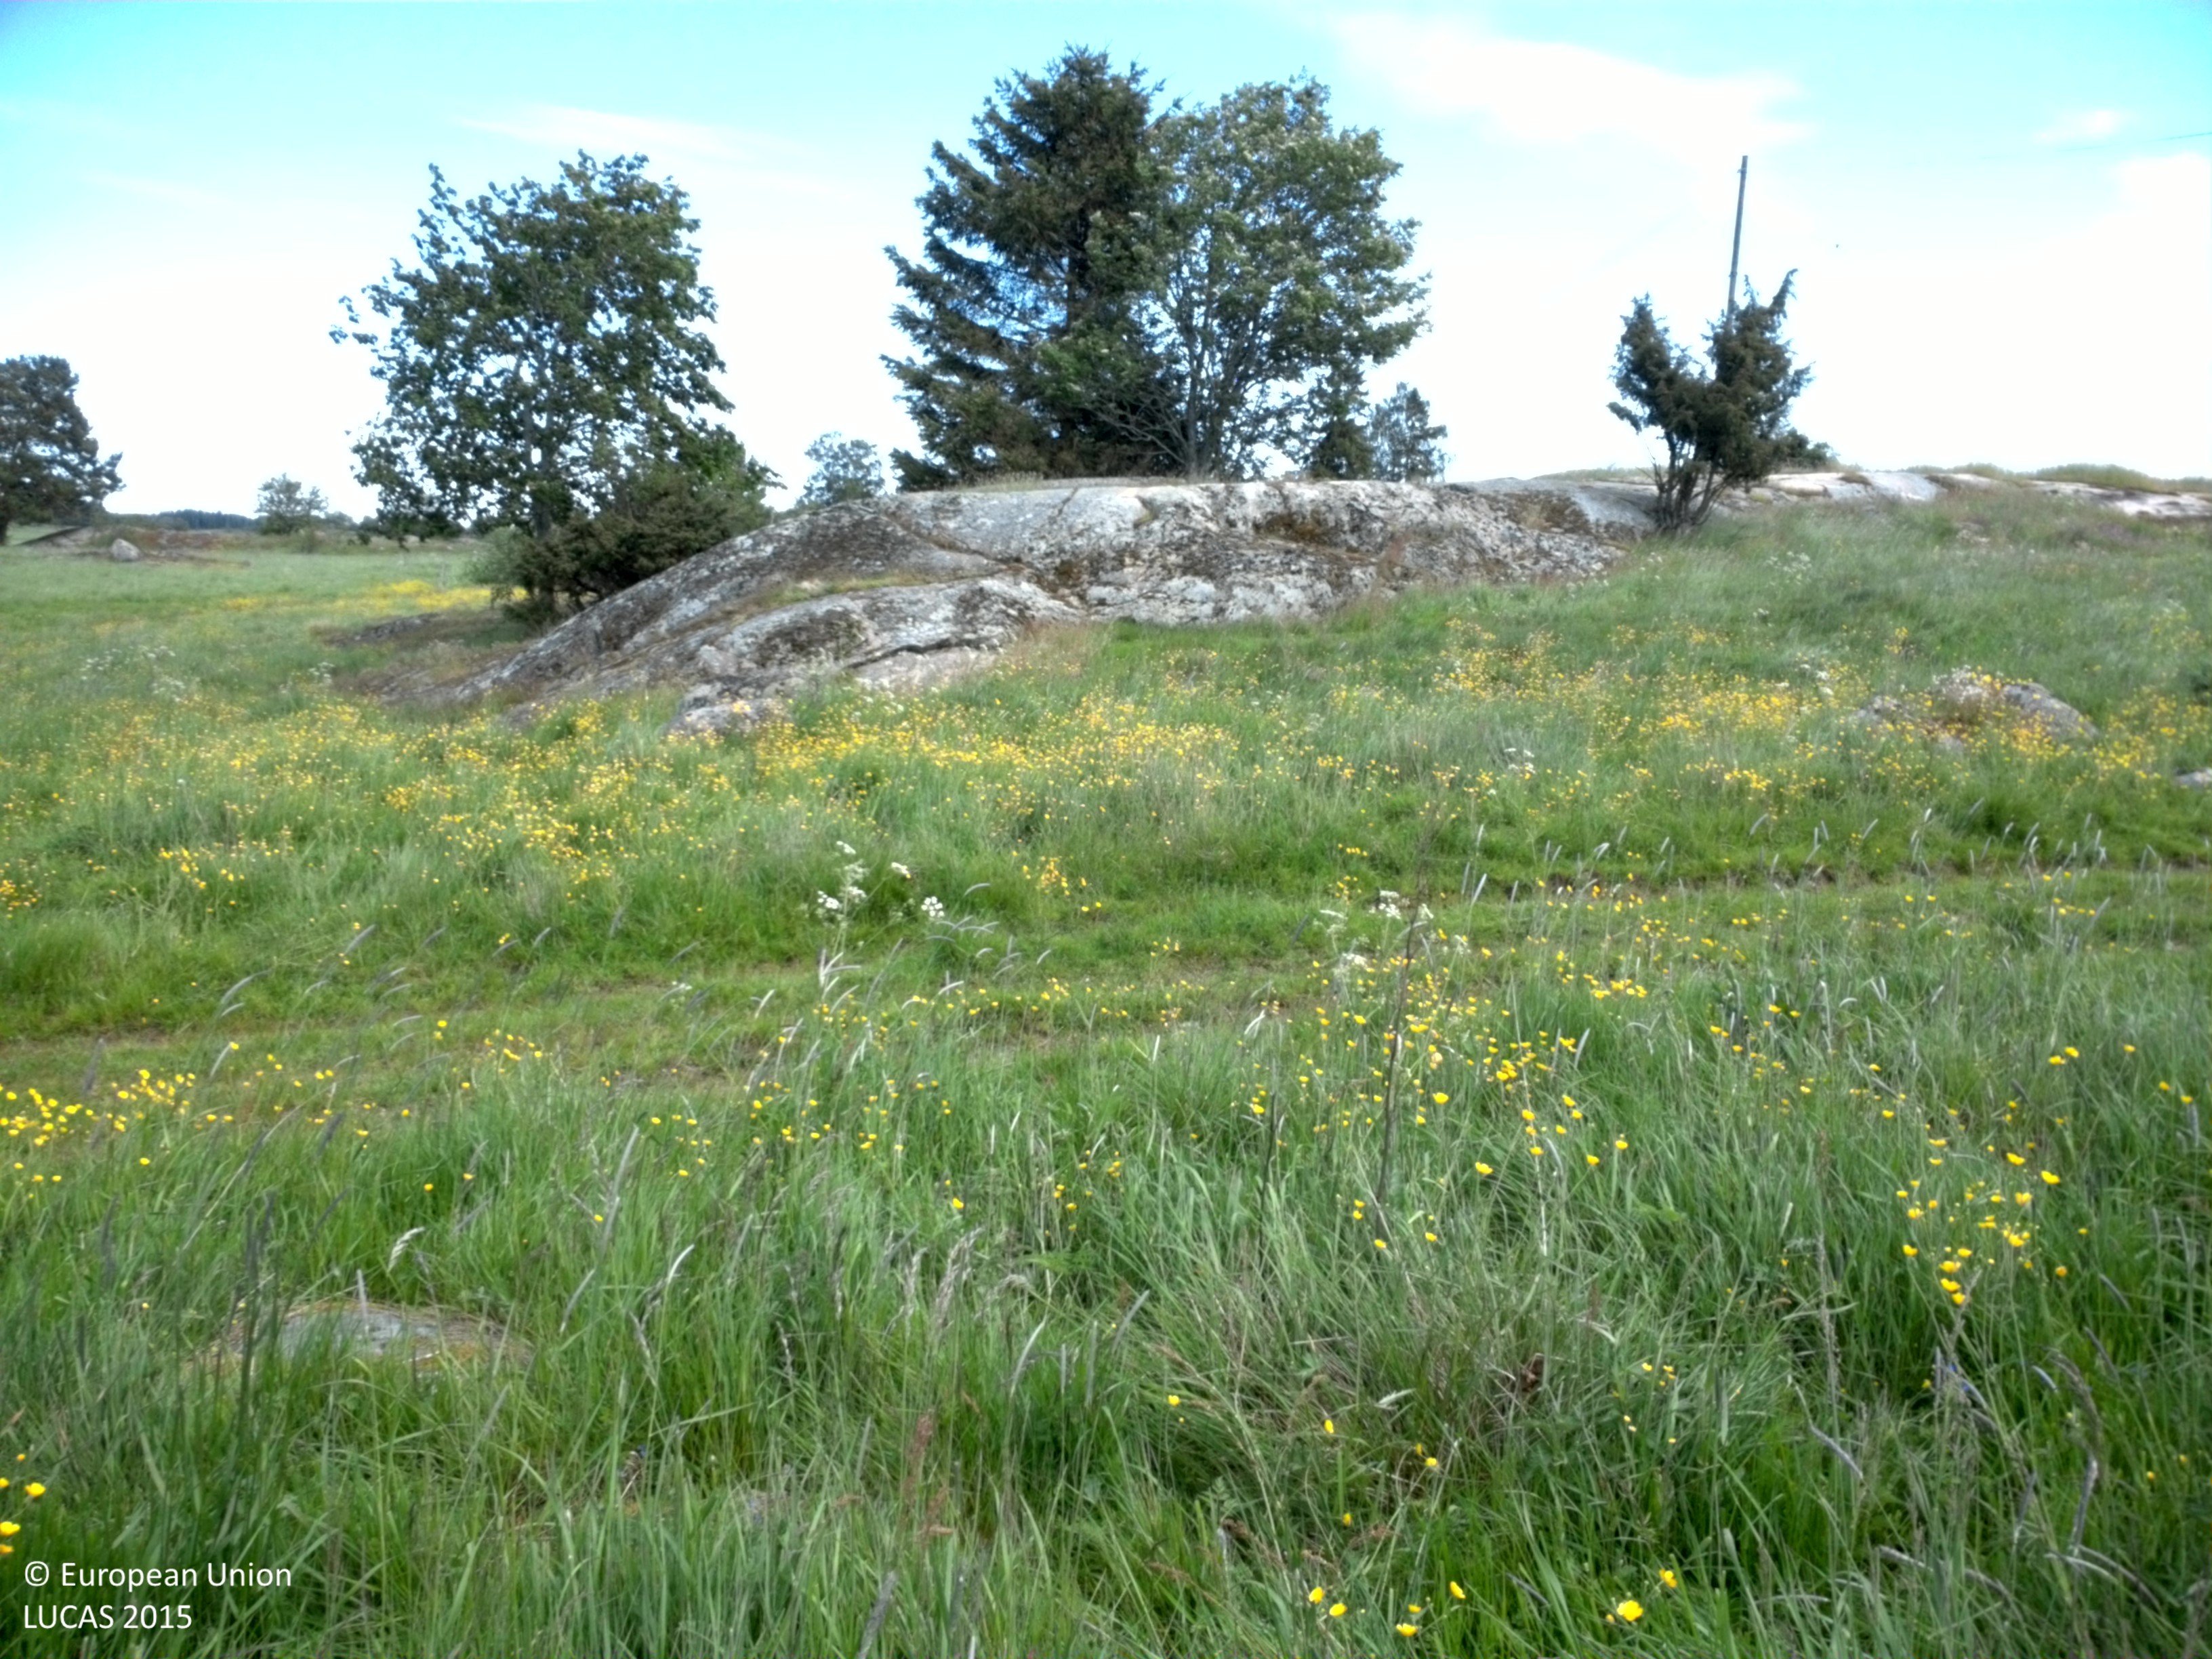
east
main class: Grassland
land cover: Grassland with sparse tree/shrub cover
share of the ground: > 75 %
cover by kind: herbaceous plants 90 %, broadleaved forest trees 5 %, shrubs 5 %
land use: Agriculture (excluding fallow land and kitchen gardens)
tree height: > 5 m
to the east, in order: Grassland with sparse tree/shrub cover; Tracks; Grassland with sparse tree/shrub cover; Rock outcrops; Grassland with sparse tree/shrub cover; Rock outcrops; Grassland with sparse tree/shrub cover; Fences; Tracks; Grassland with sparse tree/shrub cover; Tracks; Rye; Spontaneously vegetated surfaces
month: June
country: SE
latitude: 58.4744
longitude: 15.7731
